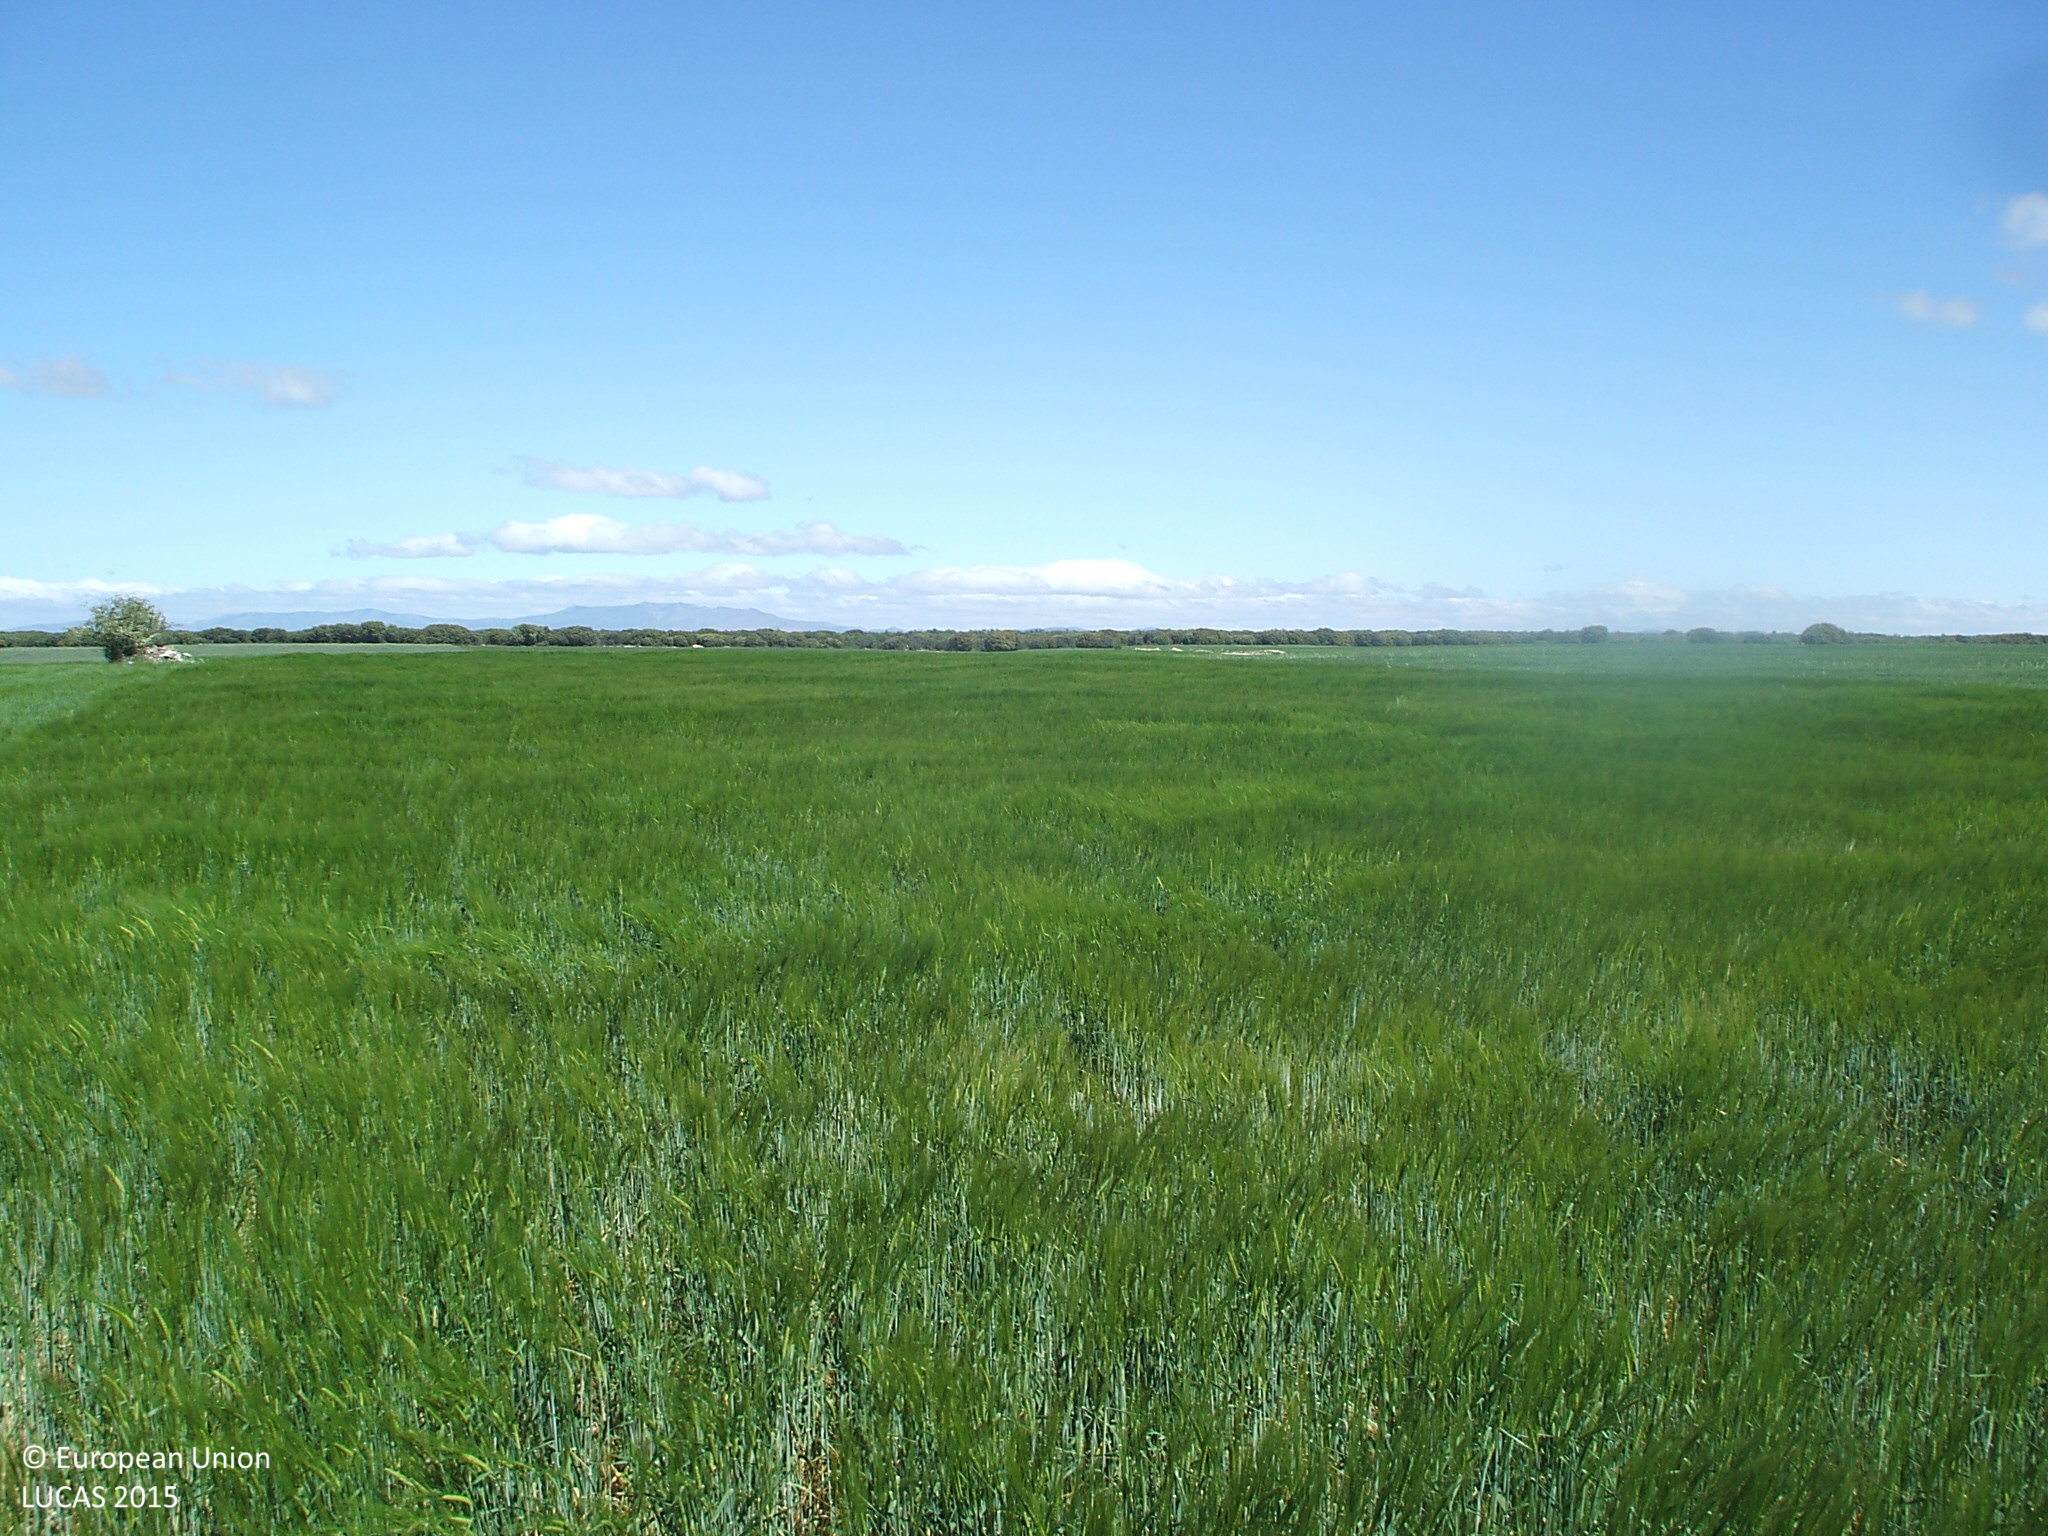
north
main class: Cropland
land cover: Barley
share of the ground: > 75 %
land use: Agriculture (excluding fallow land and kitchen gardens)
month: May
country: ES
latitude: 40.8980
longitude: -2.8647
